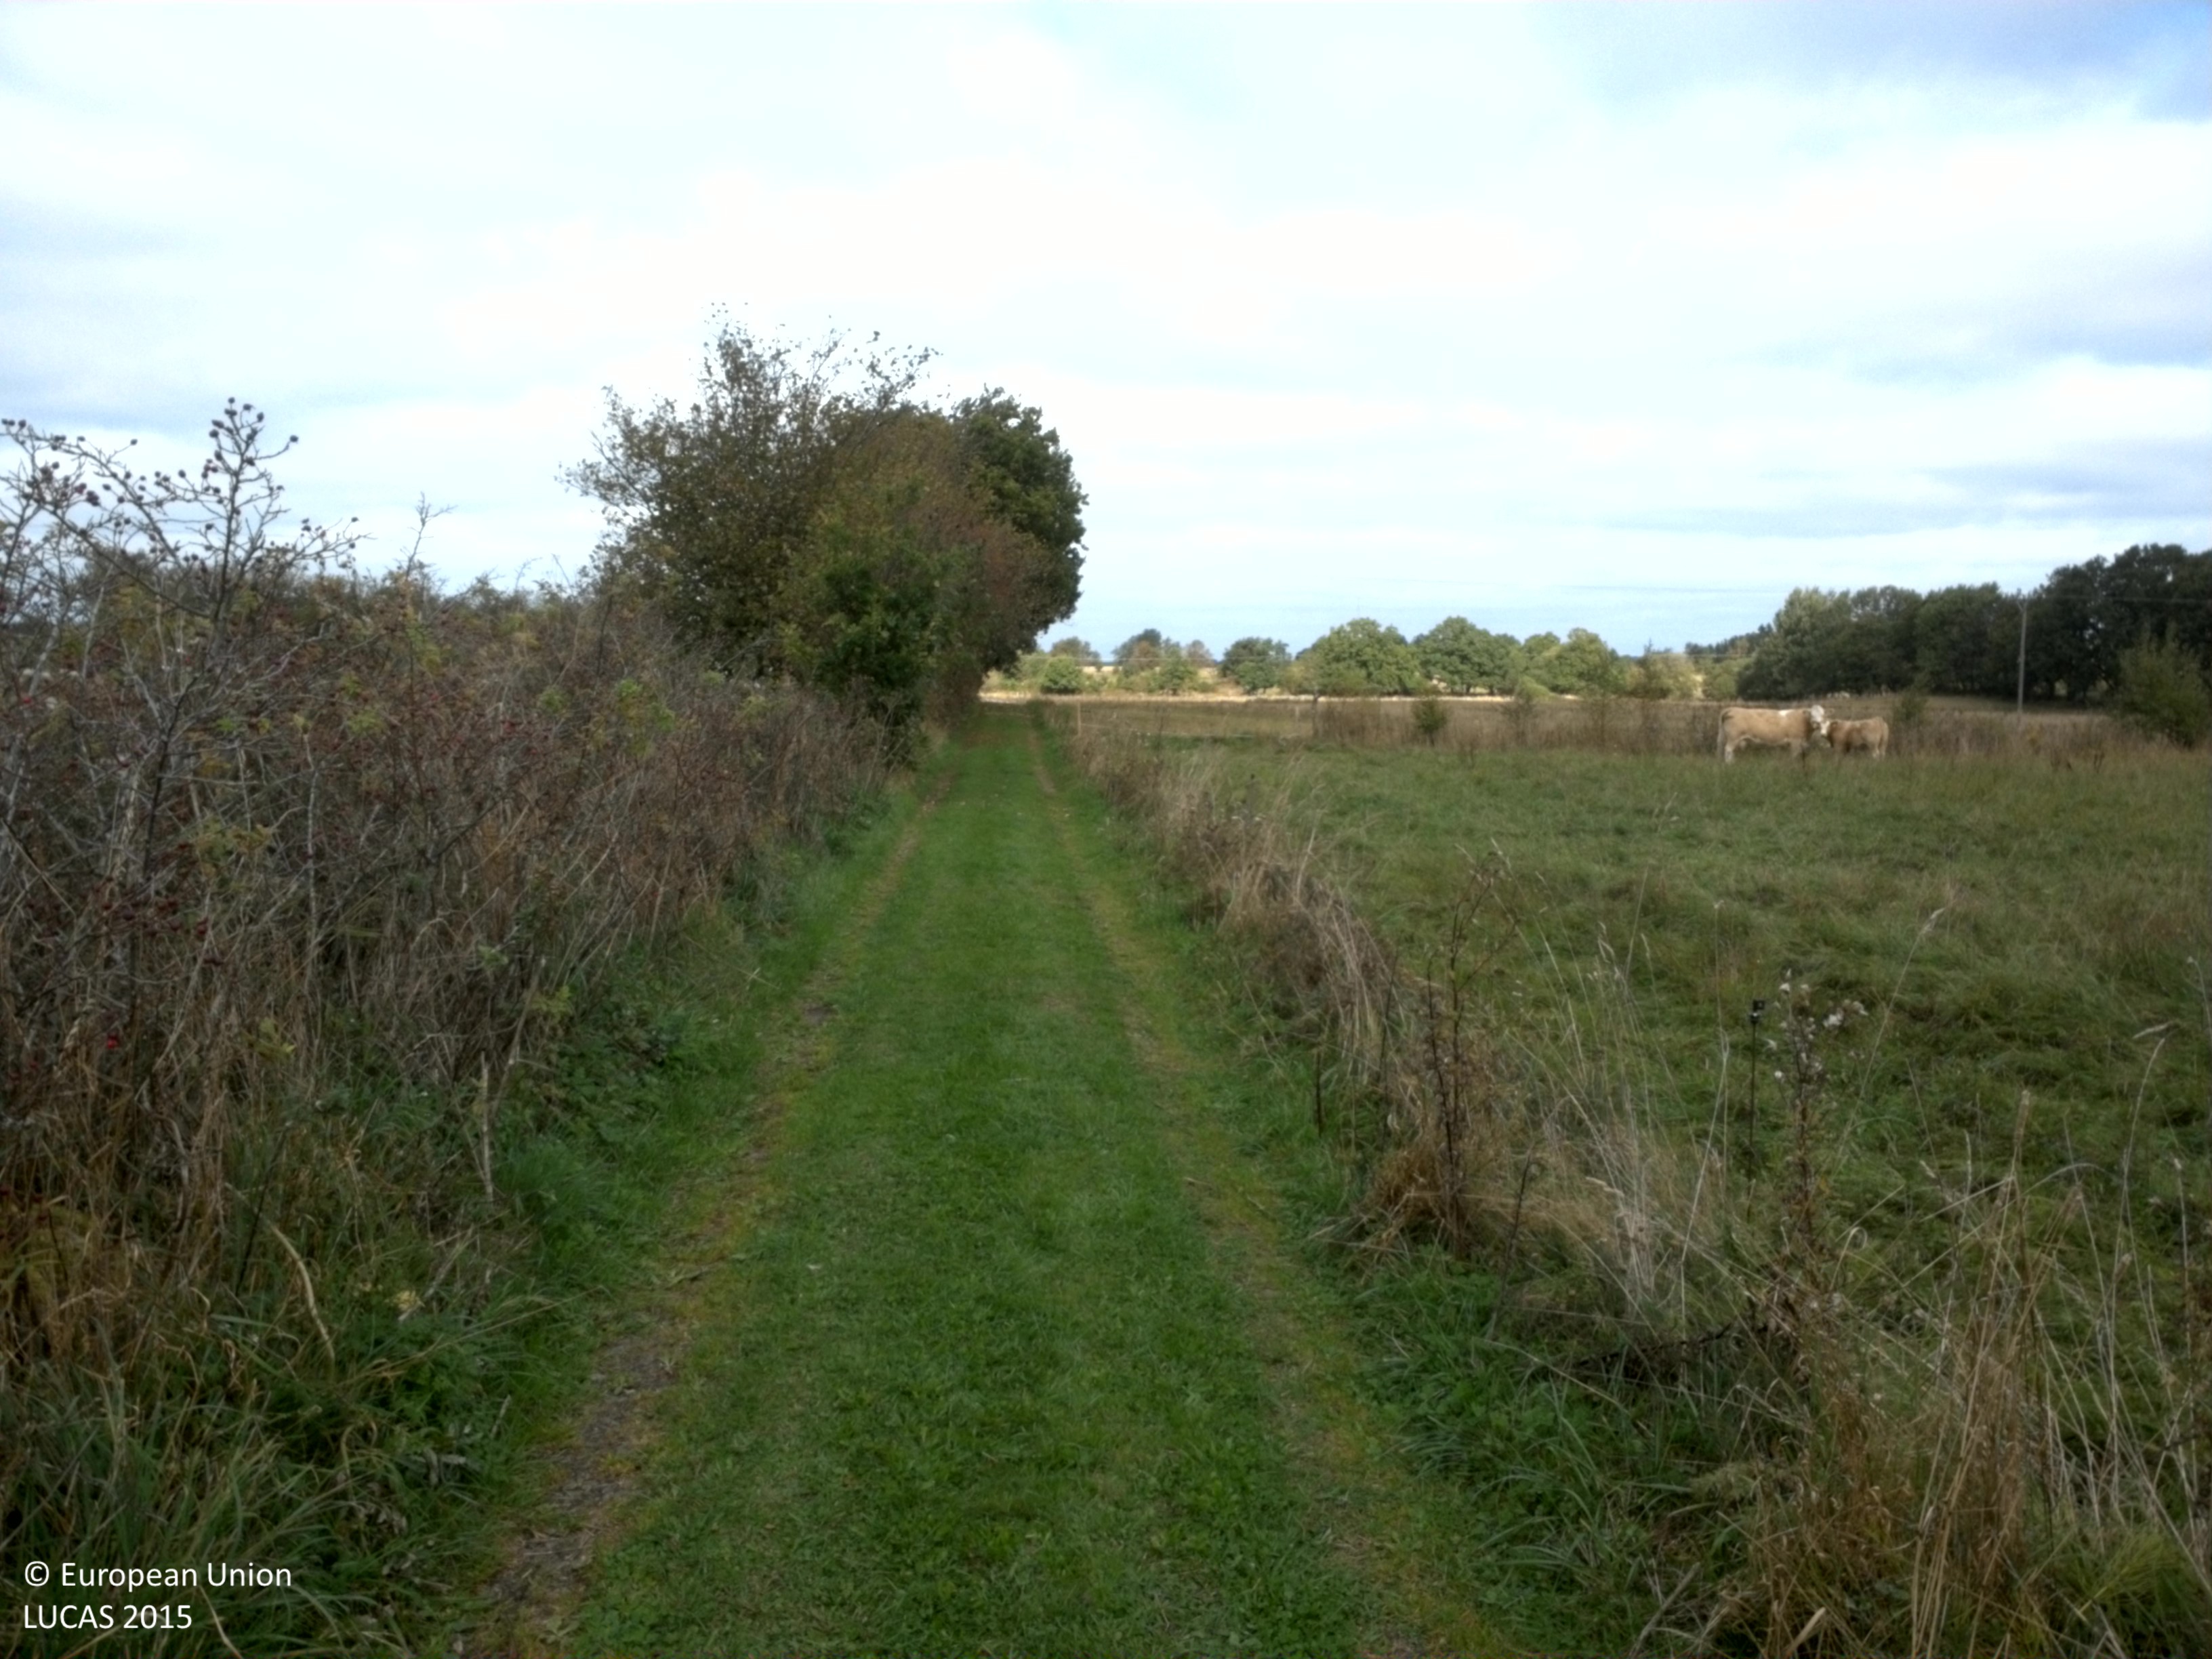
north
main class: Grassland
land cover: Grassland without tree/shrub cover
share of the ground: > 75 %
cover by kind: herbaceous plants 100 %
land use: Agriculture (excluding fallow land and kitchen gardens)
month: October
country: SE
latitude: 55.7383
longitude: 13.7091
